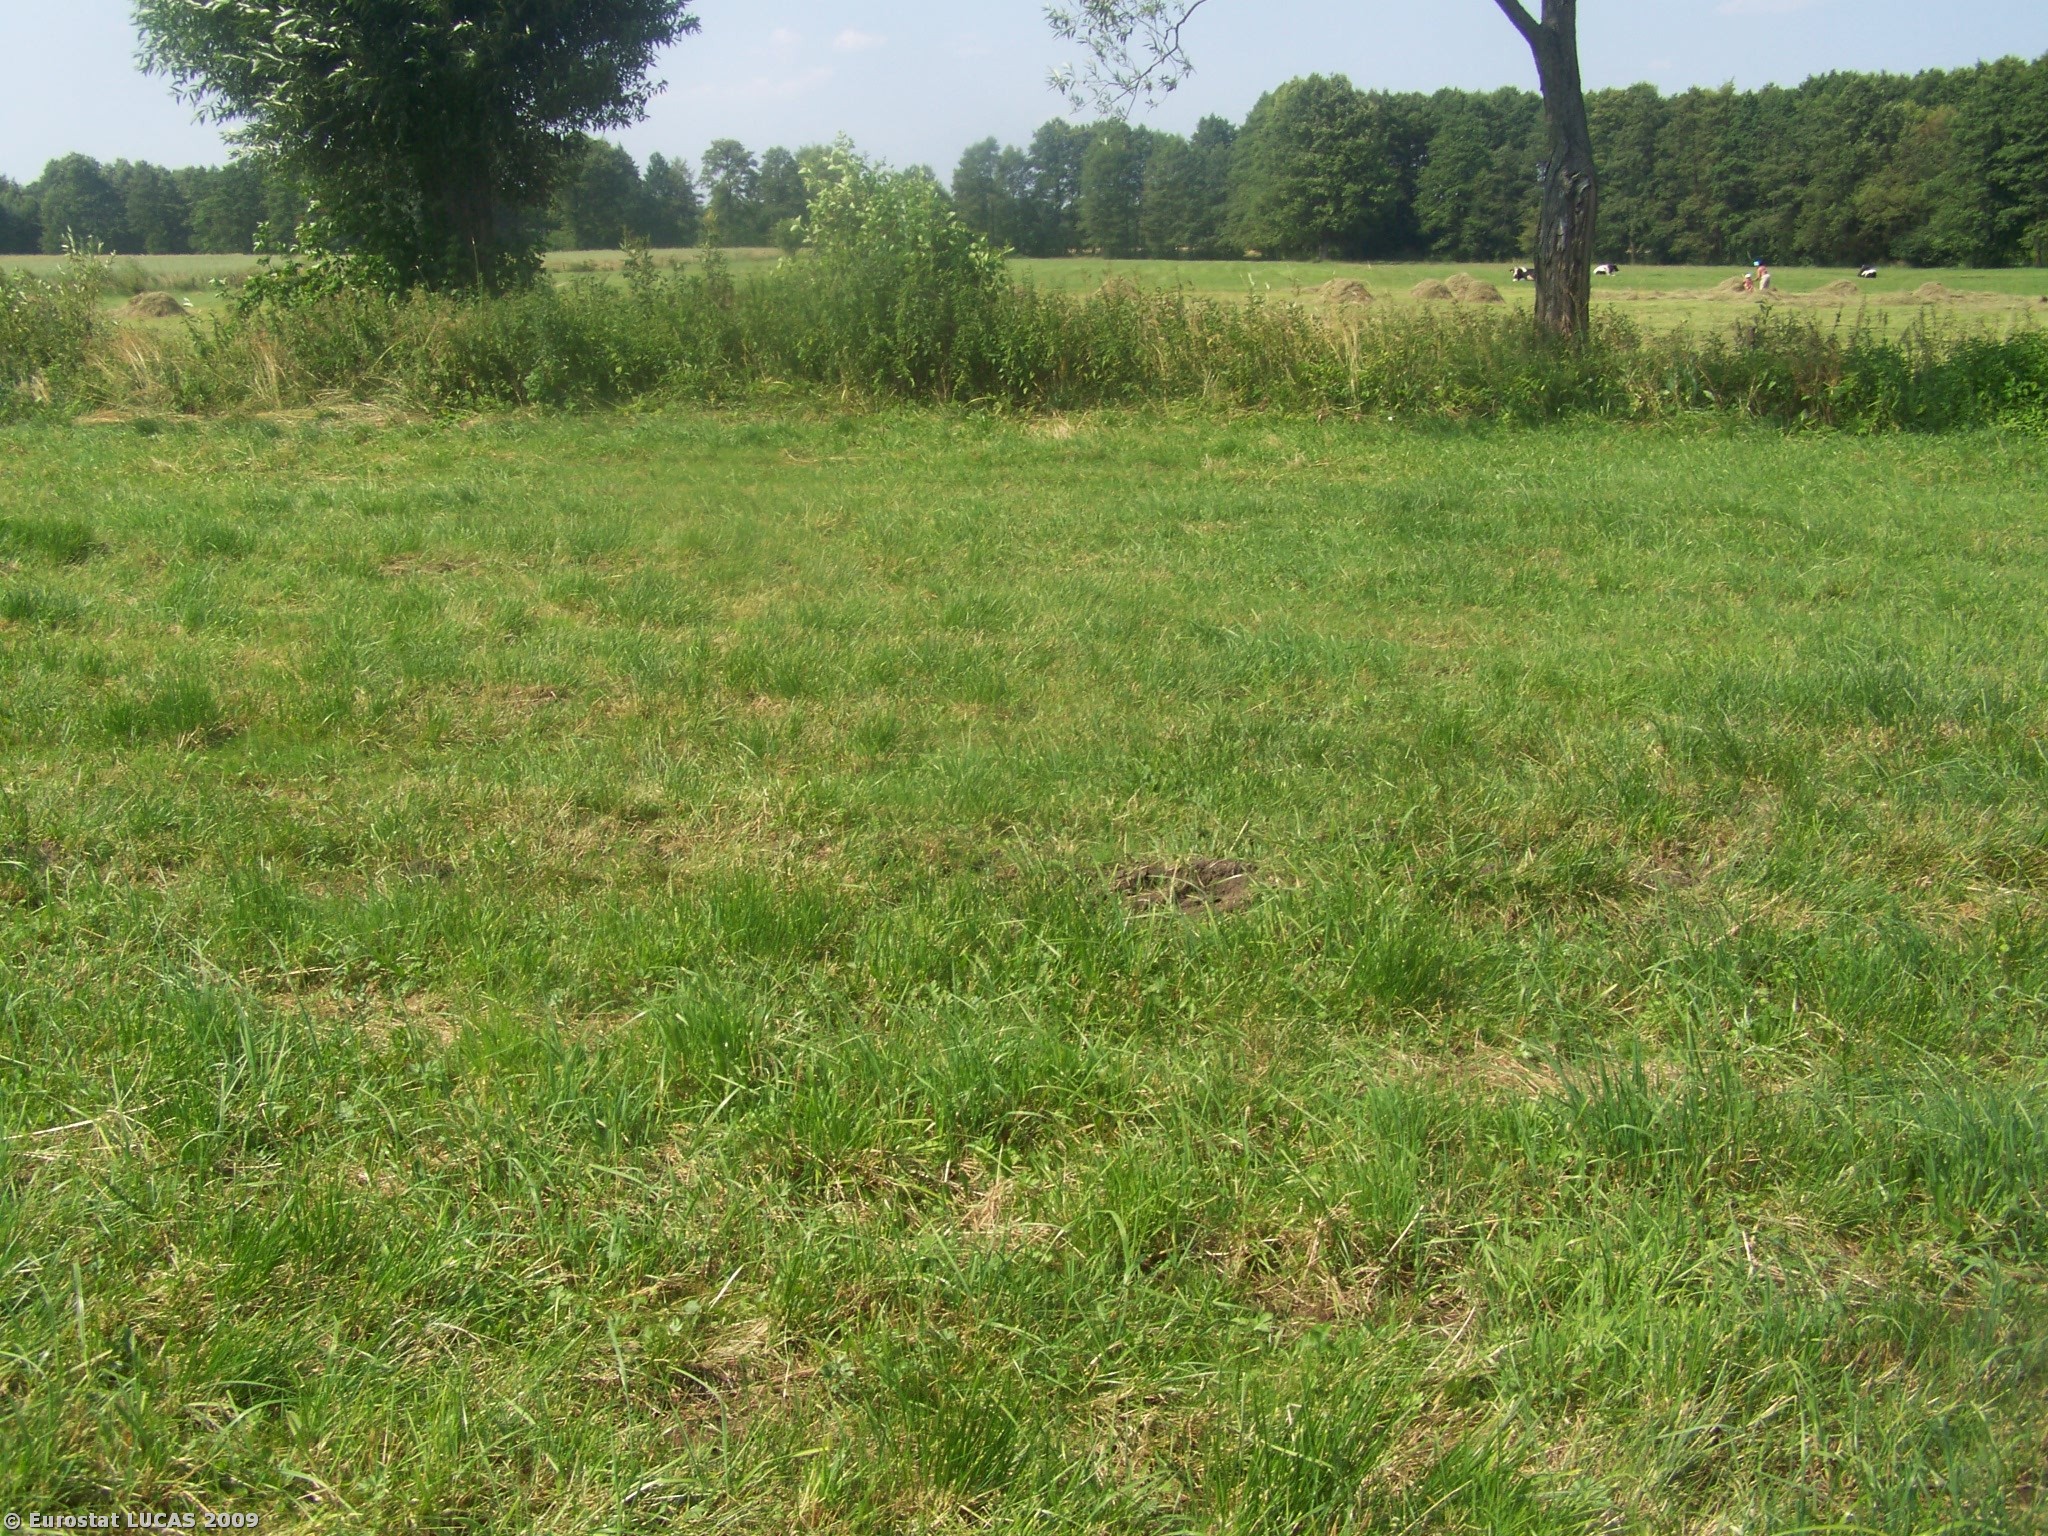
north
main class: Grassland
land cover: Grassland without tree/shrub cover
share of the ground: > 75 %
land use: Agriculture (excluding fallow land and kitchen gardens)
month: July
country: PL
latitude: 51.9648
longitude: 21.6532
